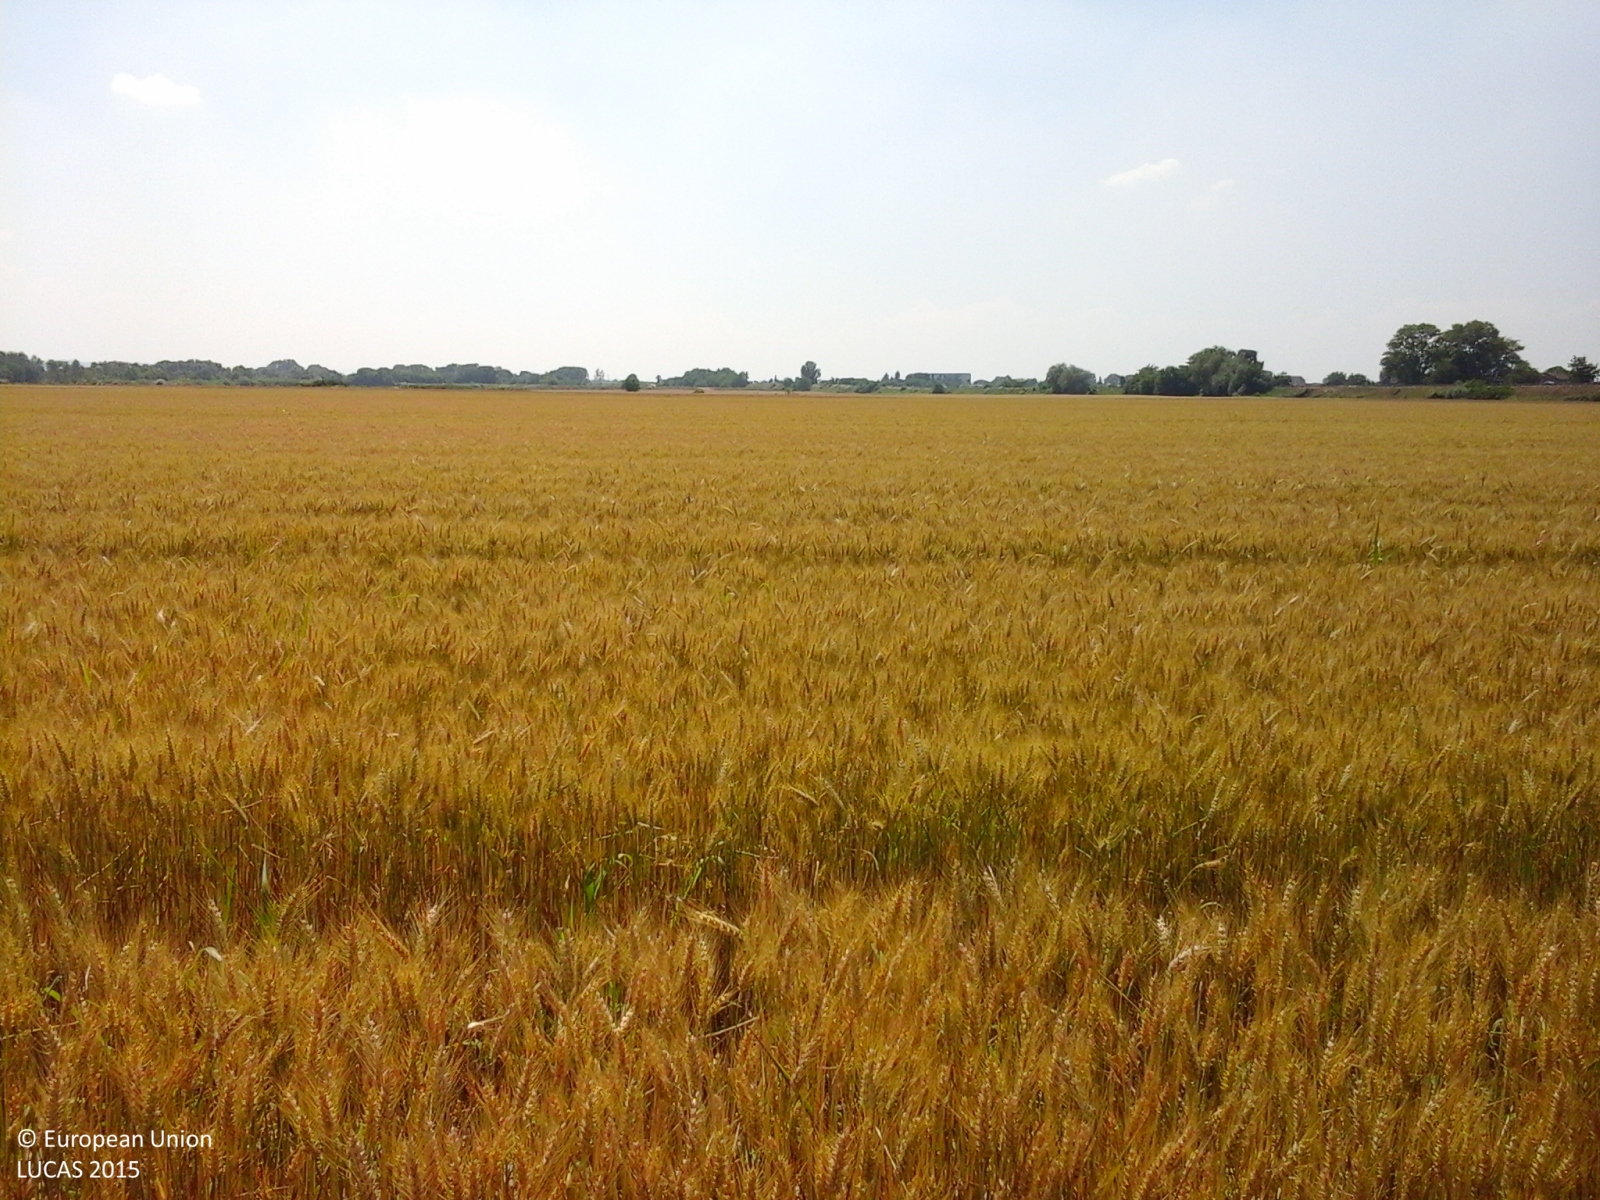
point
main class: Cropland
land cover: Common wheat
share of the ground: > 75 %
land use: Agriculture (excluding fallow land and kitchen gardens)
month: June
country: IT
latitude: 44.8638
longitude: 8.5727
